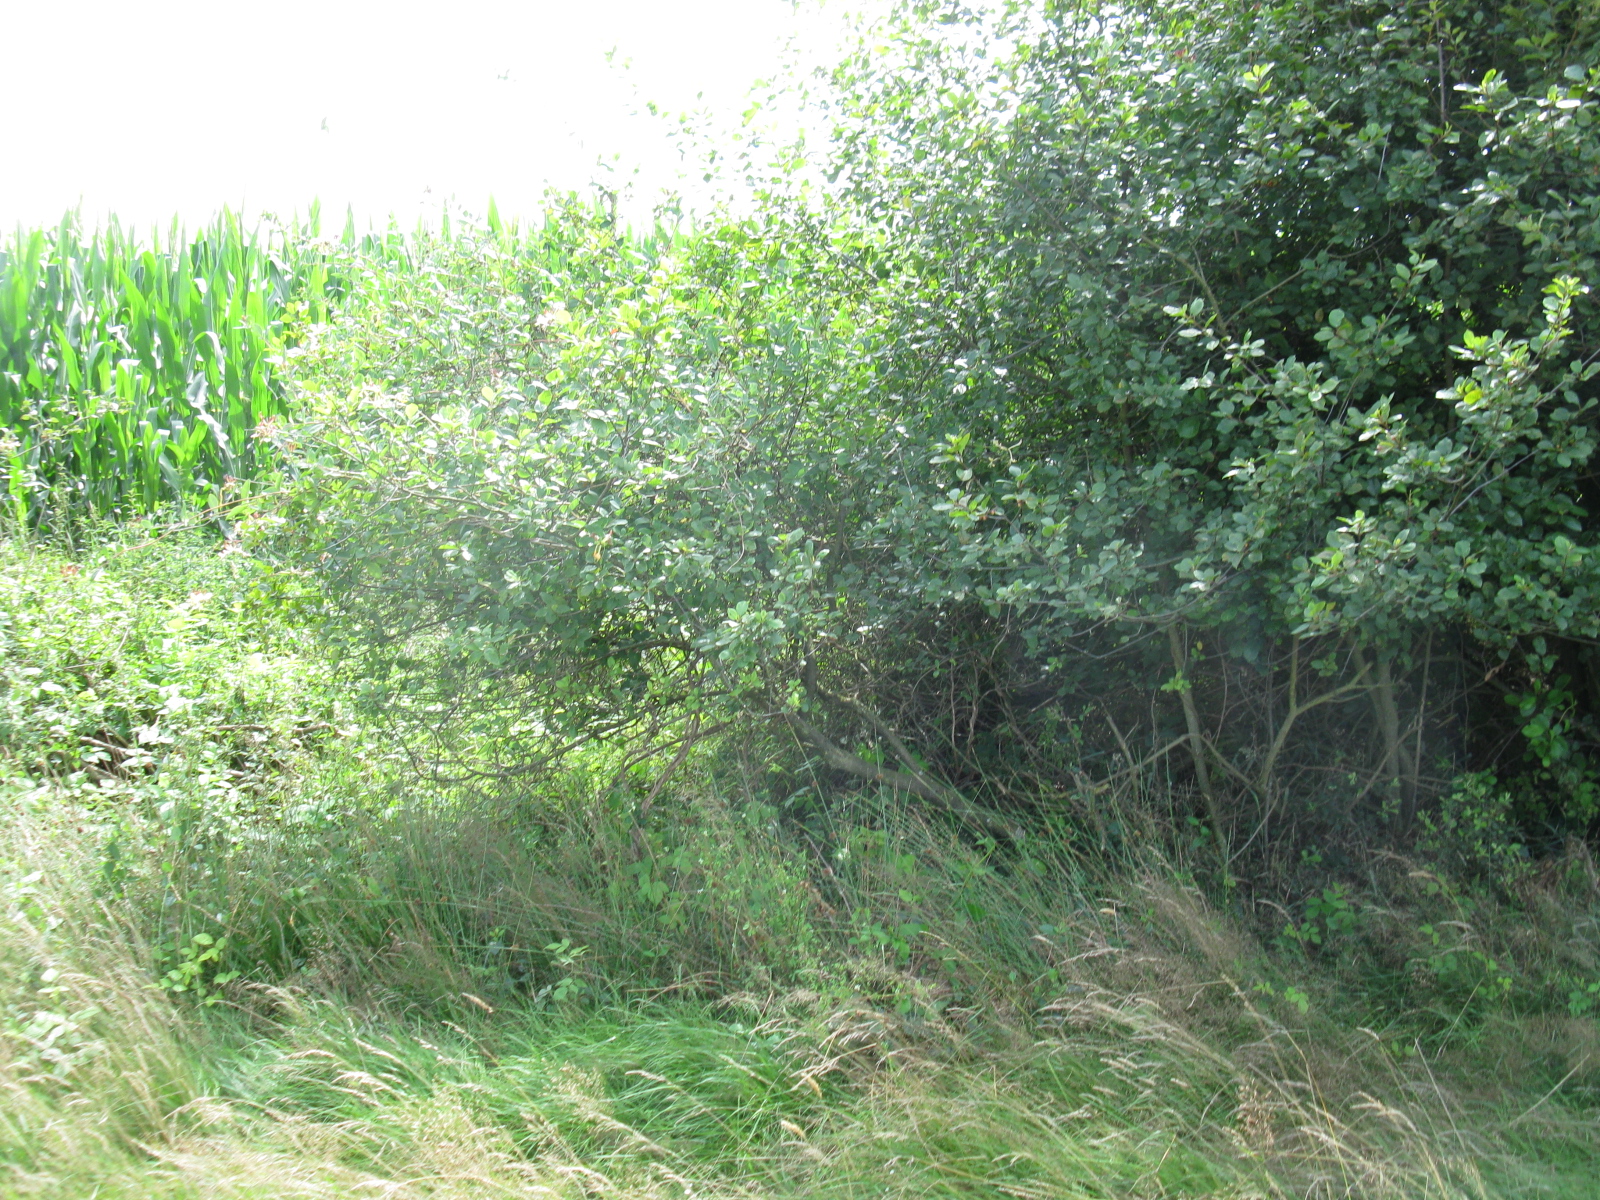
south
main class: Cropland
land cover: Rye
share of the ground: > 75 %
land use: Agriculture (excluding fallow land and kitchen gardens)
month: July
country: DE
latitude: 52.9616
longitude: 8.5267
